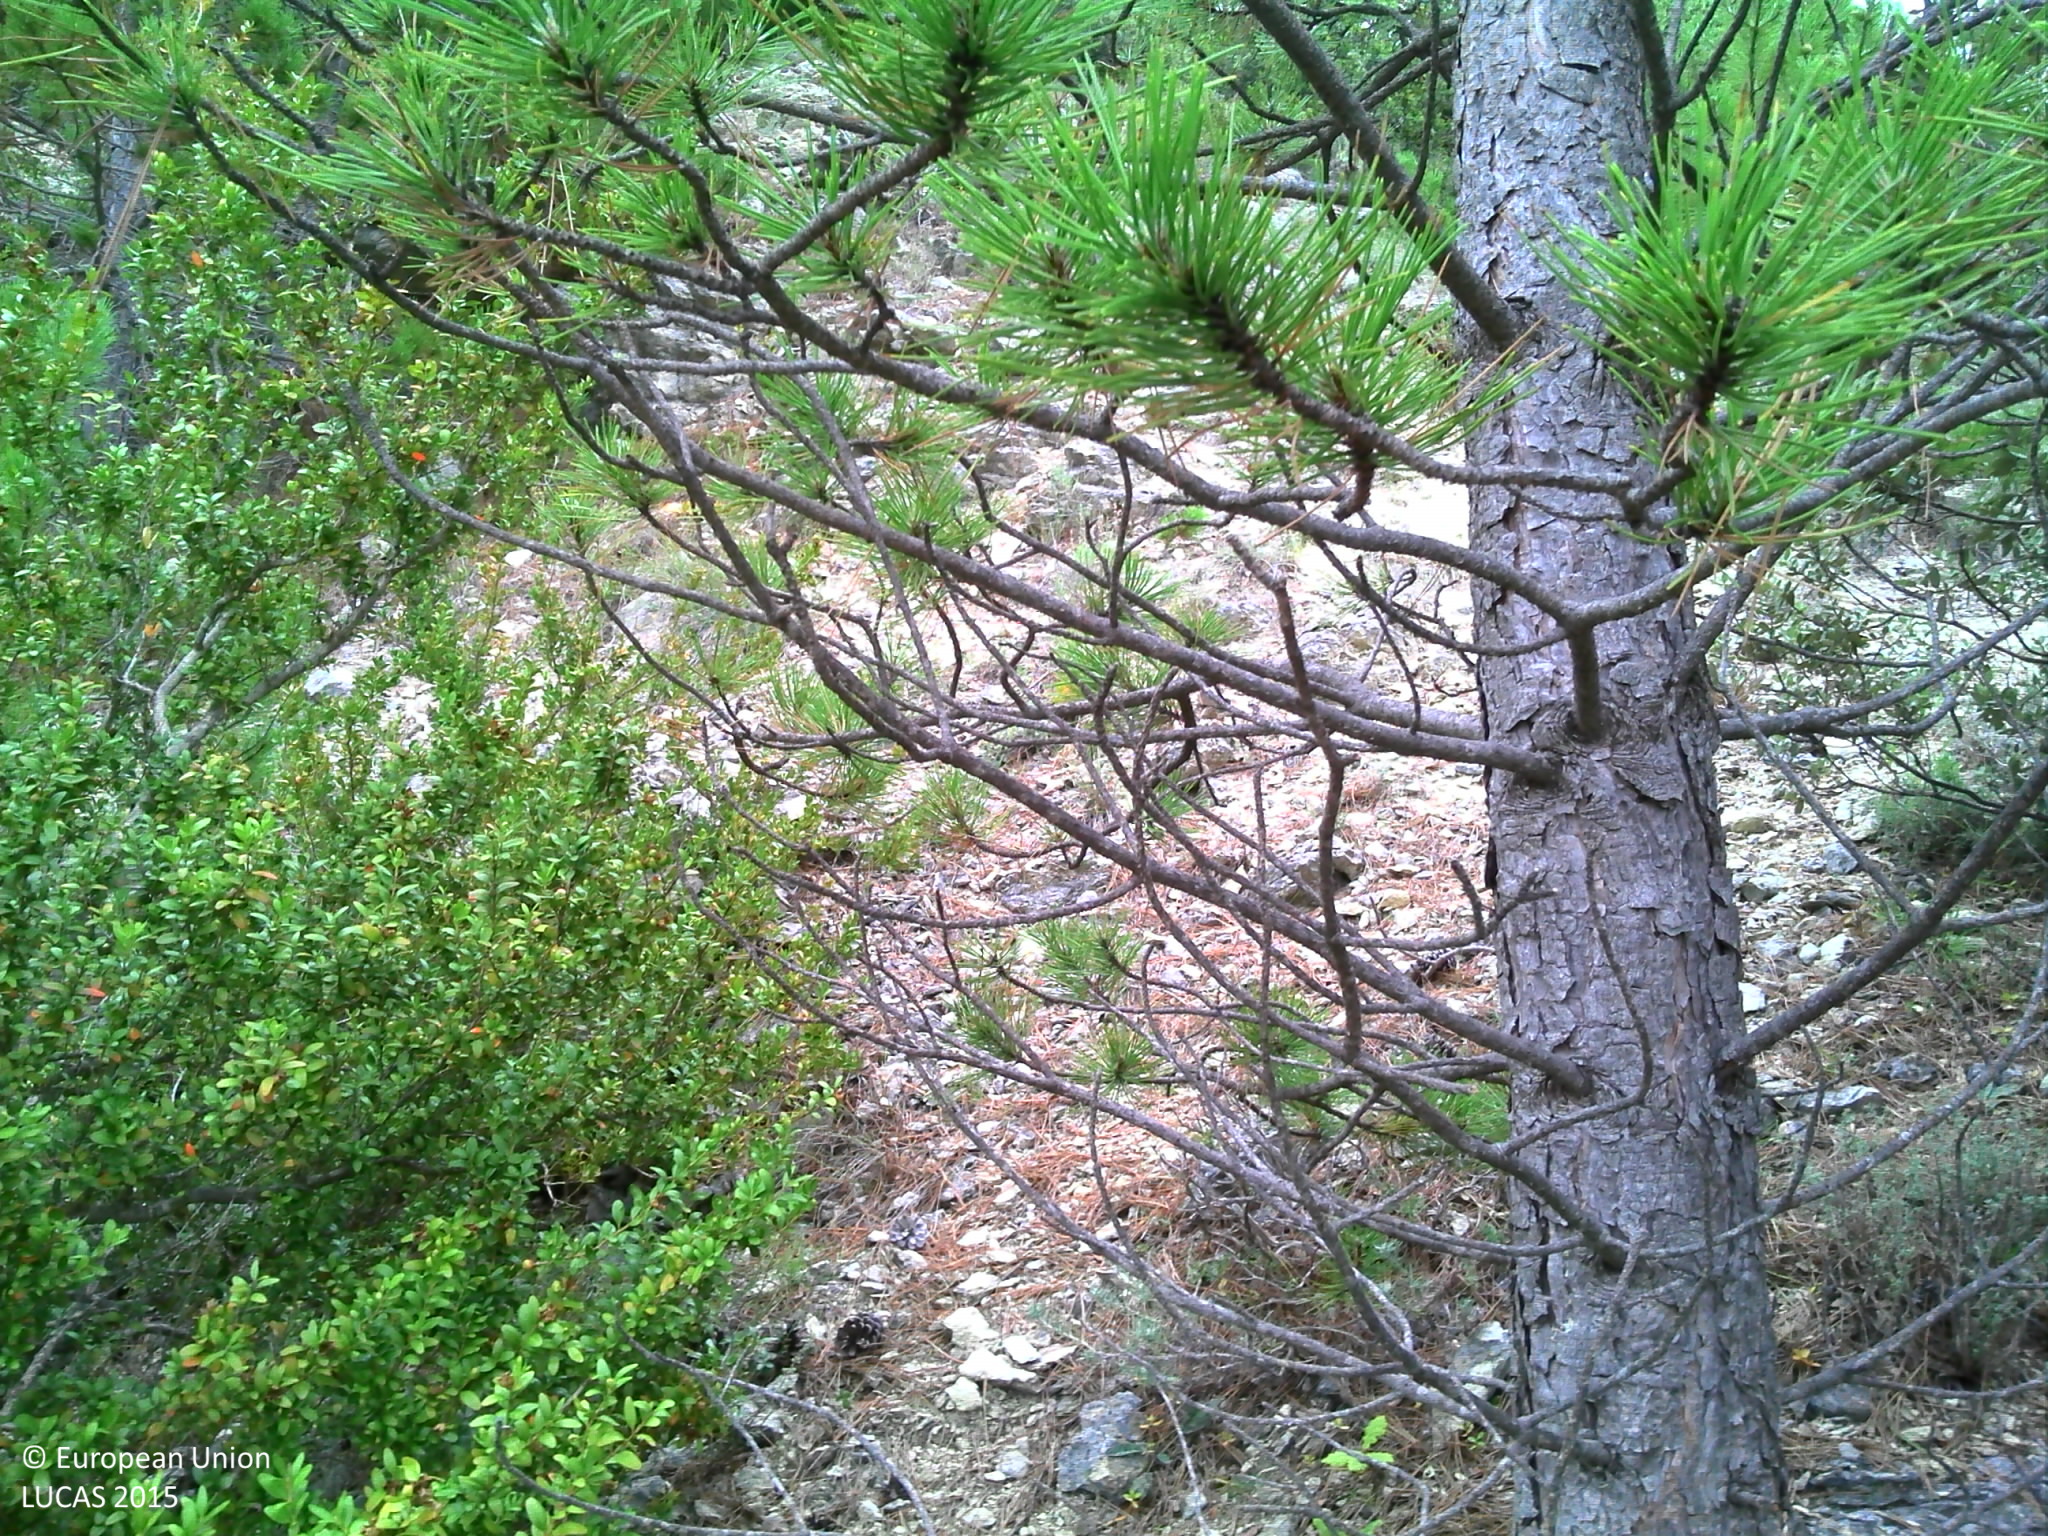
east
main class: Shrubland
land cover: Shrubland with sparse tree cover
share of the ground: > 75 %
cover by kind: shrubs 95 %, coniferous forest trees 5 %
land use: Semi-natural and natural areas not in use
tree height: < 5 m
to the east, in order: Shrubland with sparse tree cover; Rocks and stones; Broadleaved woodland; Shrubland with sparse tree cover
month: September
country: FR
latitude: 44.4141
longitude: 5.0717
